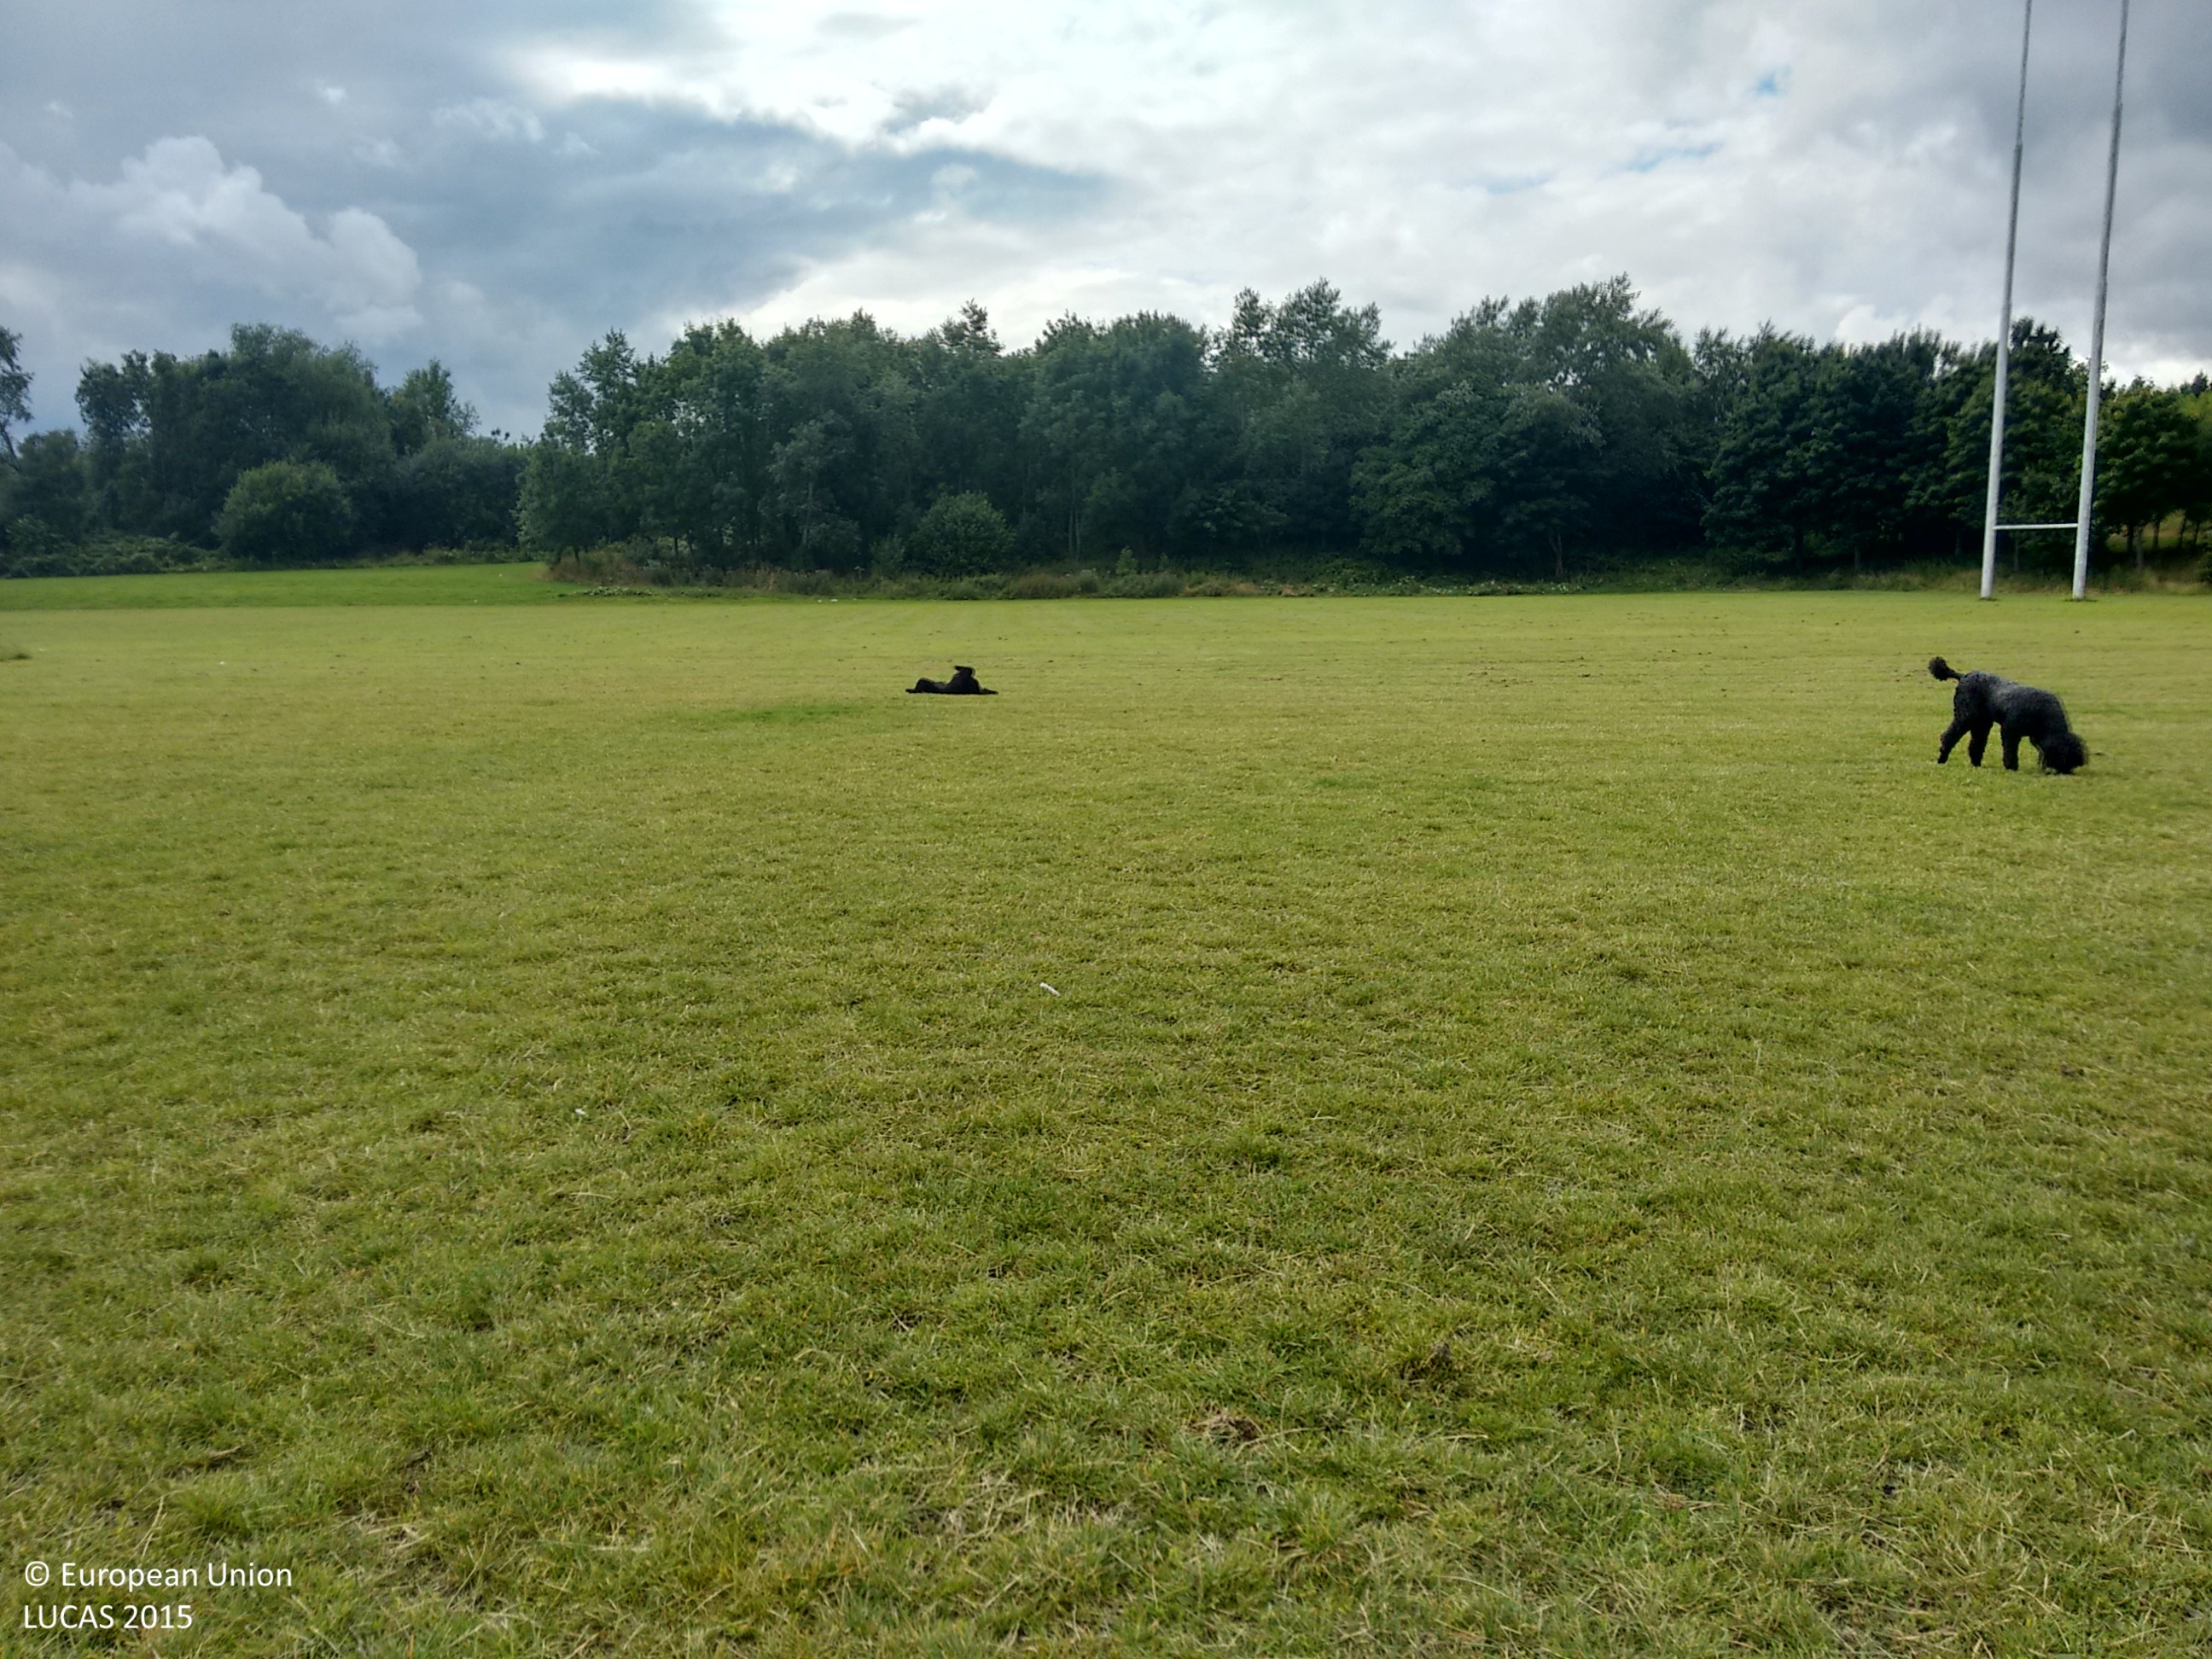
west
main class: Grassland
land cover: Grassland without tree/shrub cover
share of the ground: > 75 %
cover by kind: herbaceous plants 100 %
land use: Sport
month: July
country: GB
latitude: 52.5639
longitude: -2.0226
